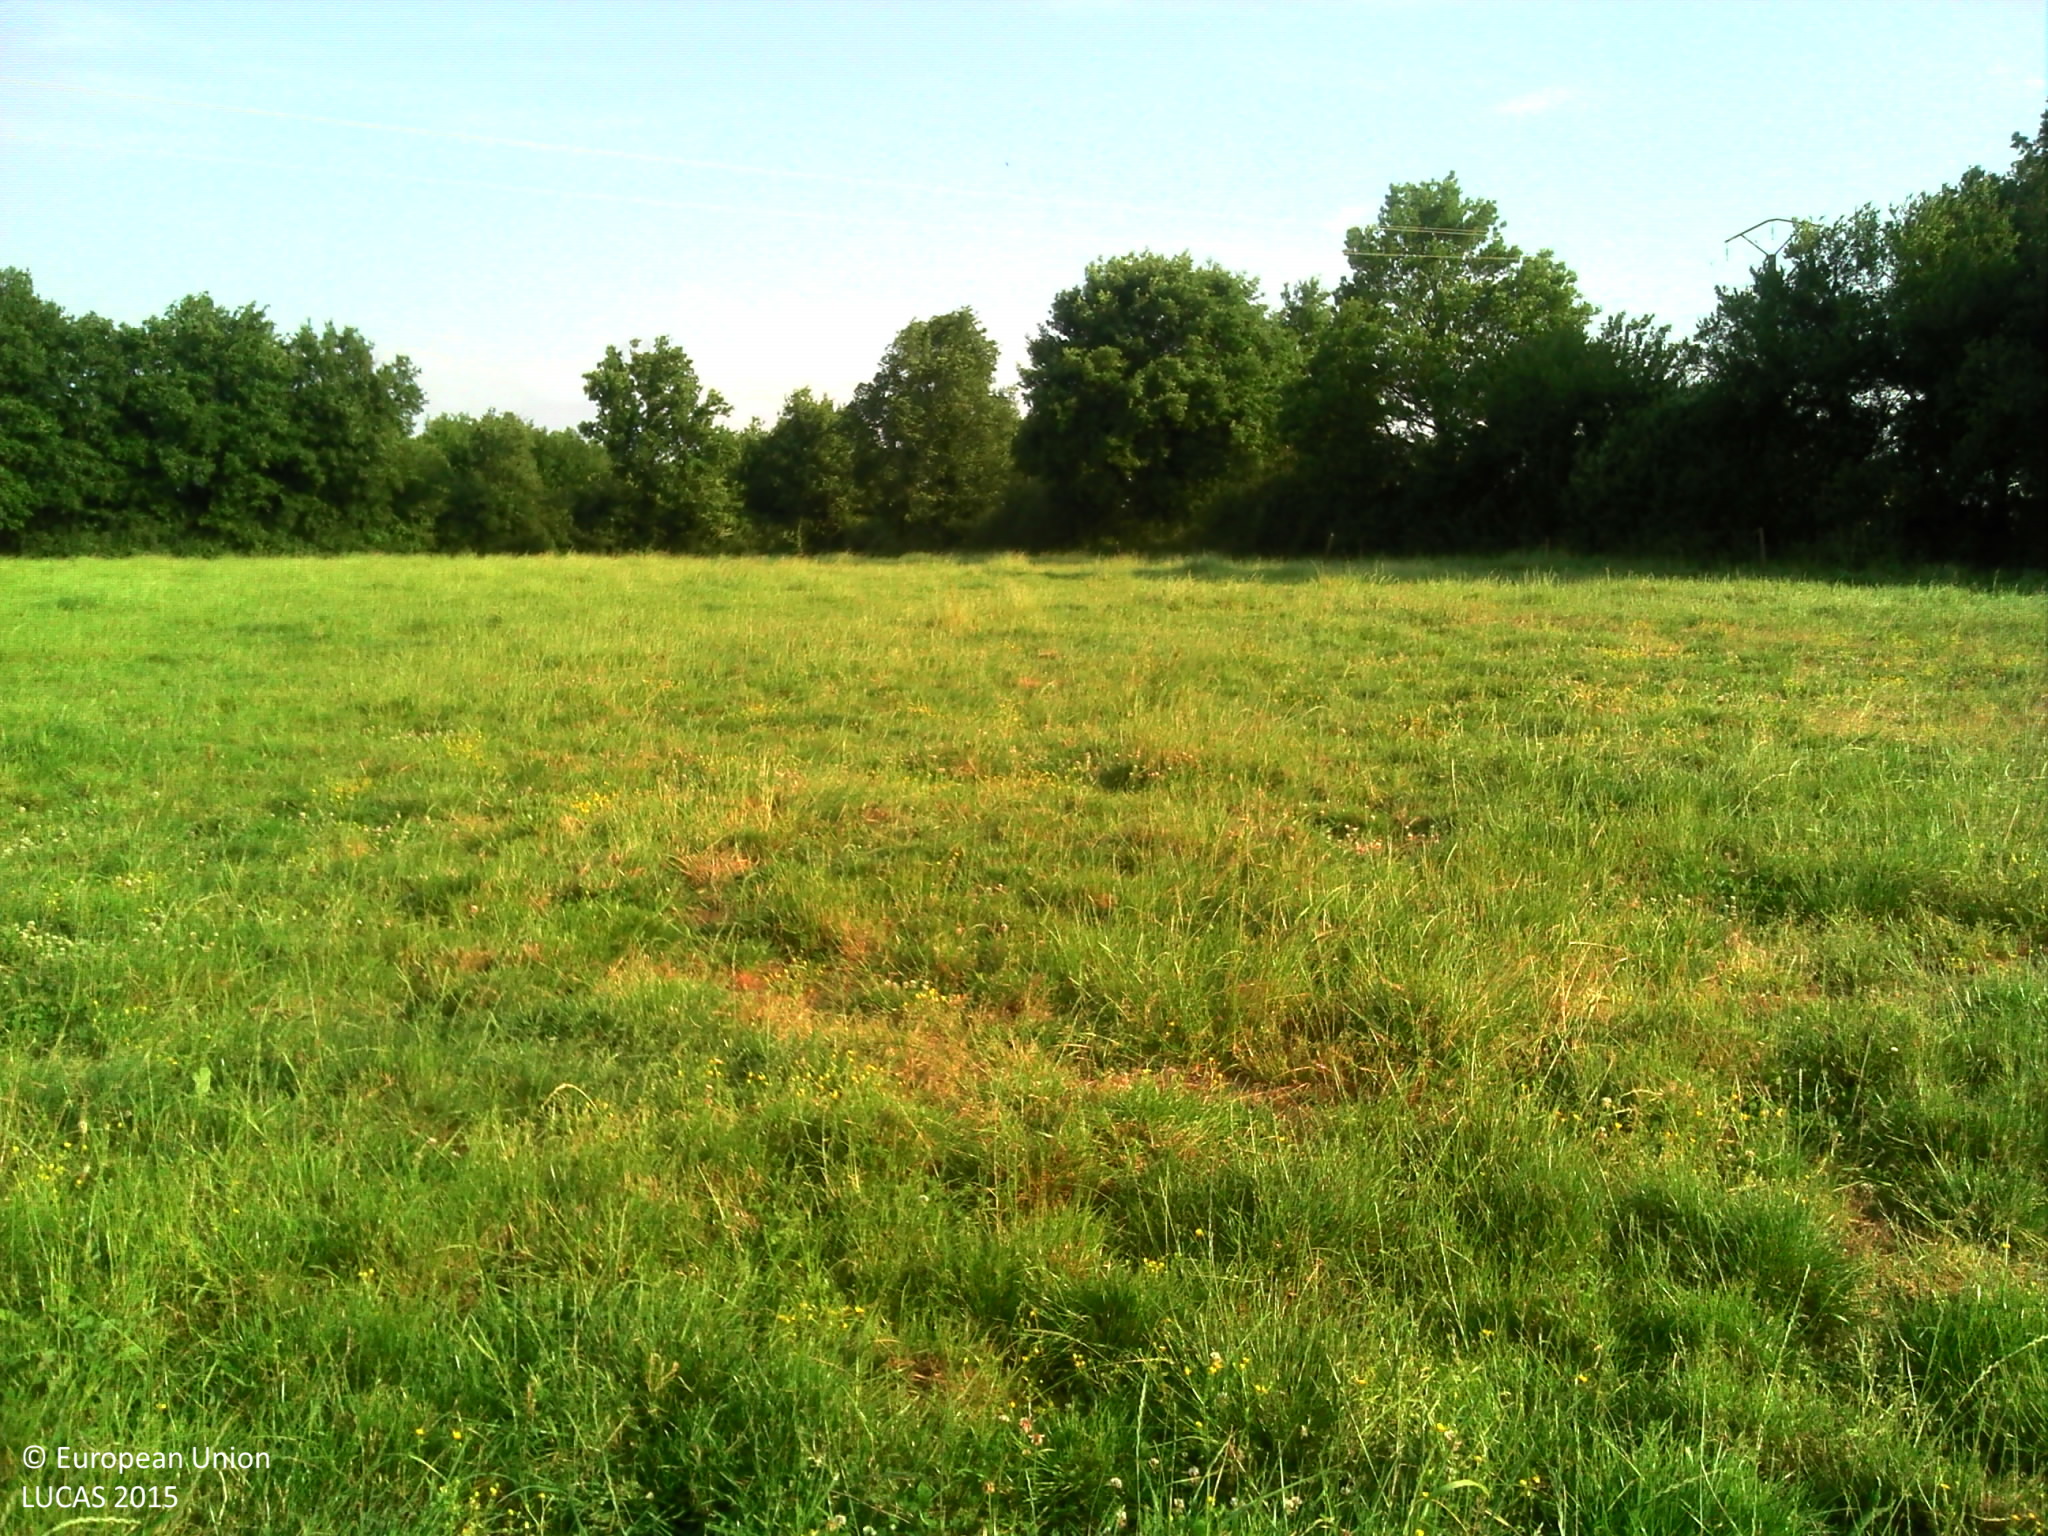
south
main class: Grassland
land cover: Grassland without tree/shrub cover
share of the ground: > 75 %
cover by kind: herbaceous plants 100 %
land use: Agriculture (excluding fallow land and kitchen gardens)
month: June
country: FR
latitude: 46.8254
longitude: -1.6158
